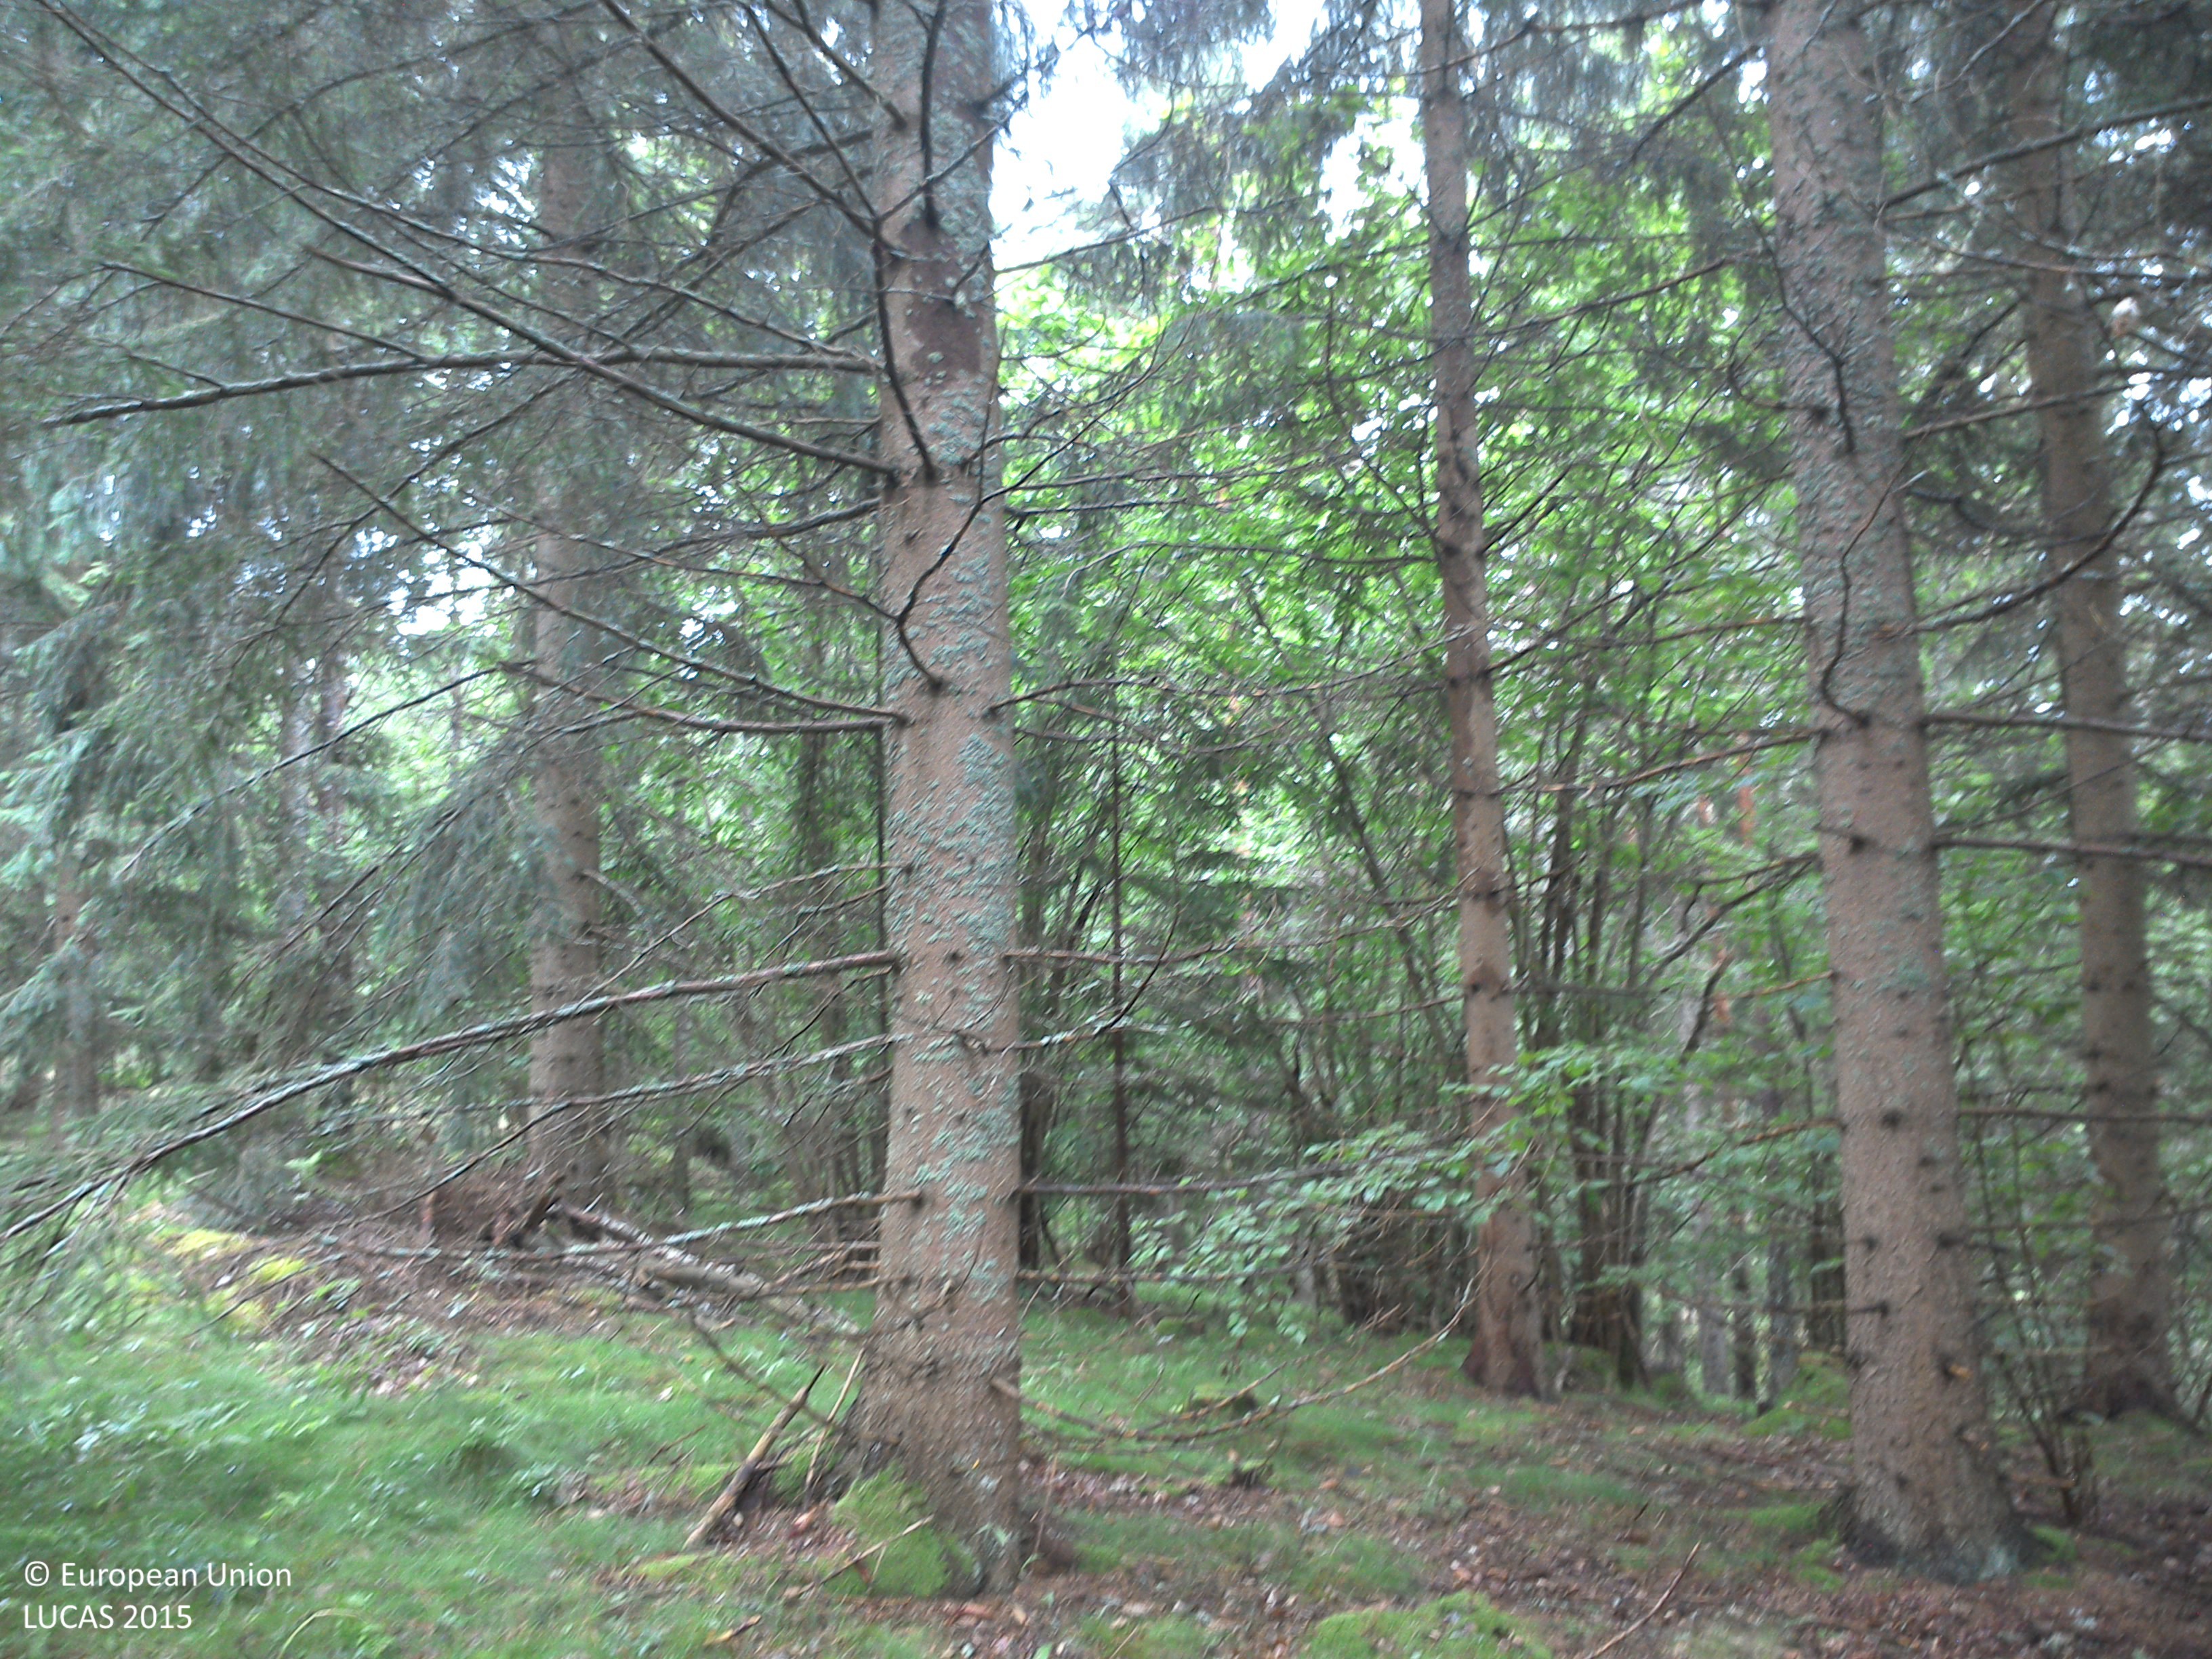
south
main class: Woodland
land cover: Spruce dominated coniferous woodland
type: boreal forest
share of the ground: 50 - 75 %
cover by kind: coniferous forest trees 60 %, herbaceous plants 40 %
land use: Forestry
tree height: > 5 m
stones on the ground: < 10 %
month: August
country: SE
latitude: 58.2527
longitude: 15.4645
